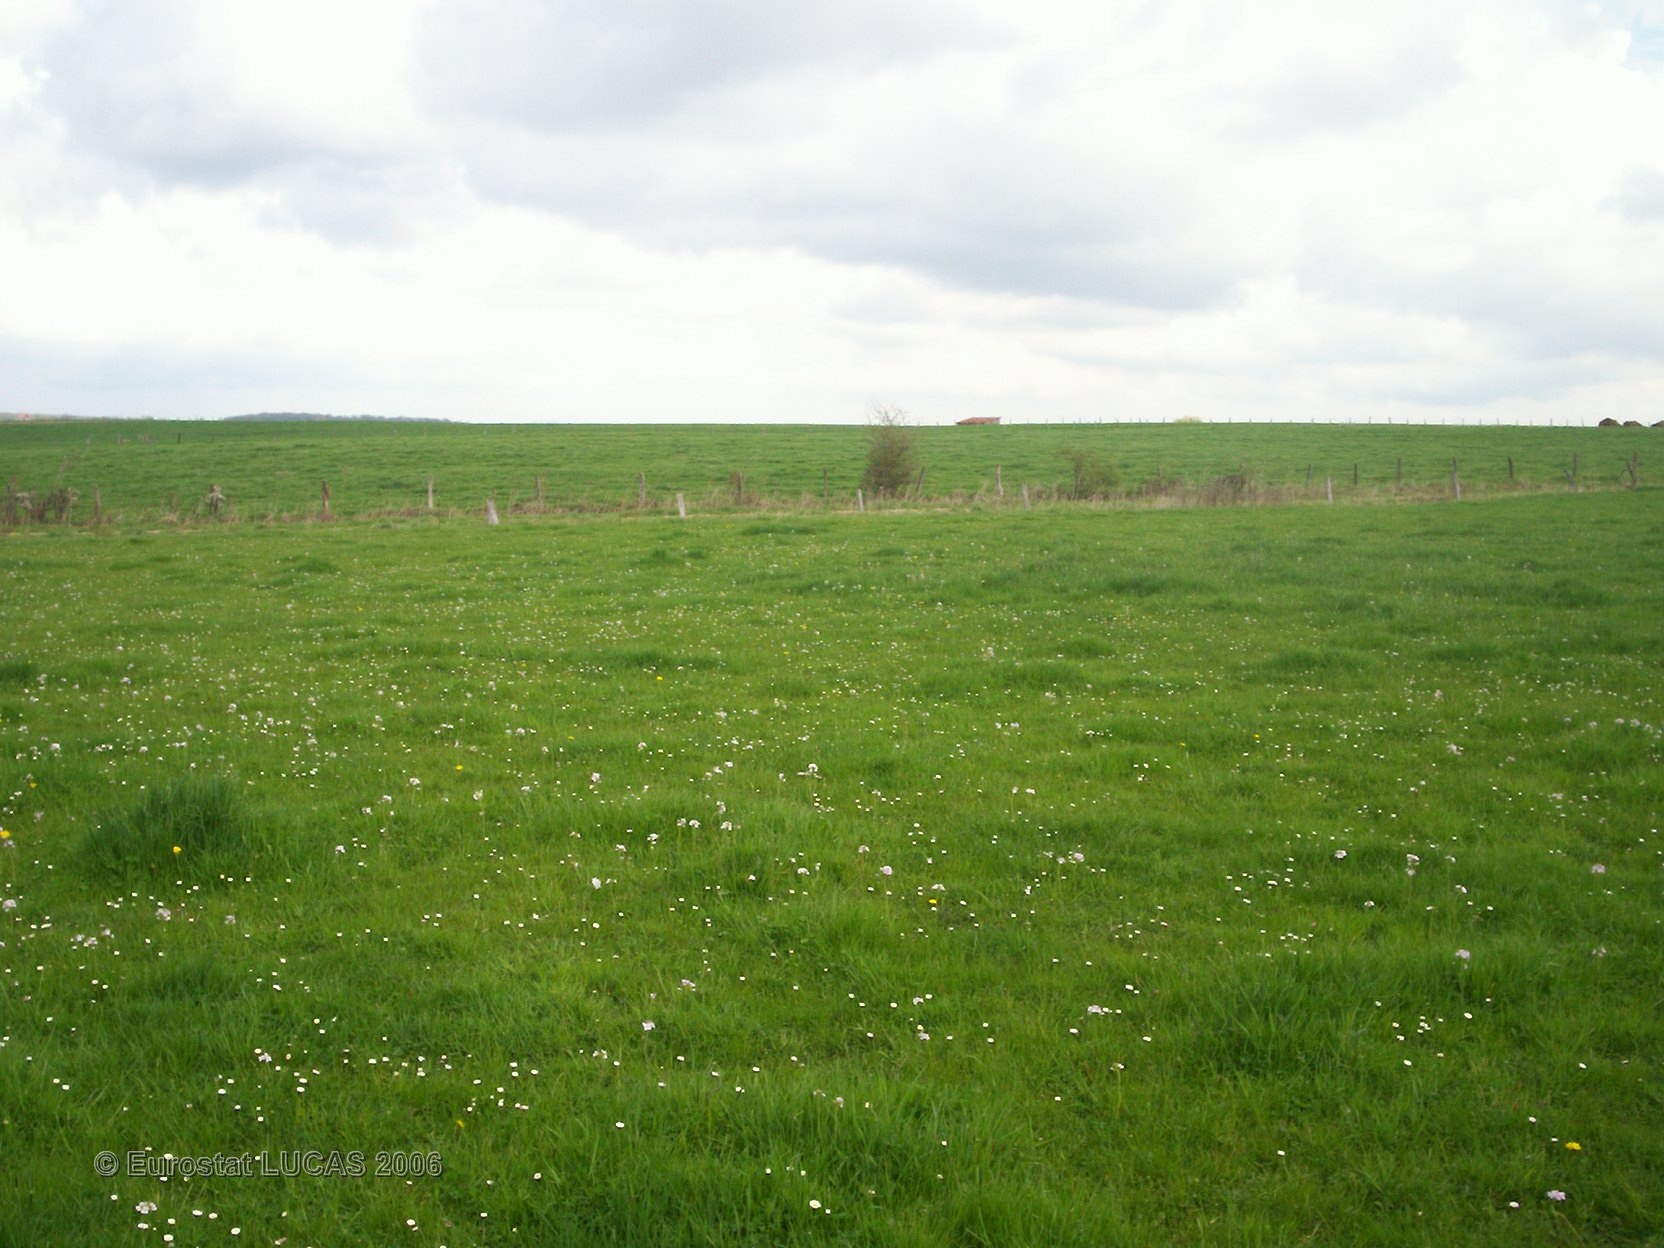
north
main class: Grassland
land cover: Grassland without tree/shrub cover
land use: Agriculture (excluding fallow land and kitchen gardens)
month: April
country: FR
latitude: 48.7535
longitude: 6.8041
